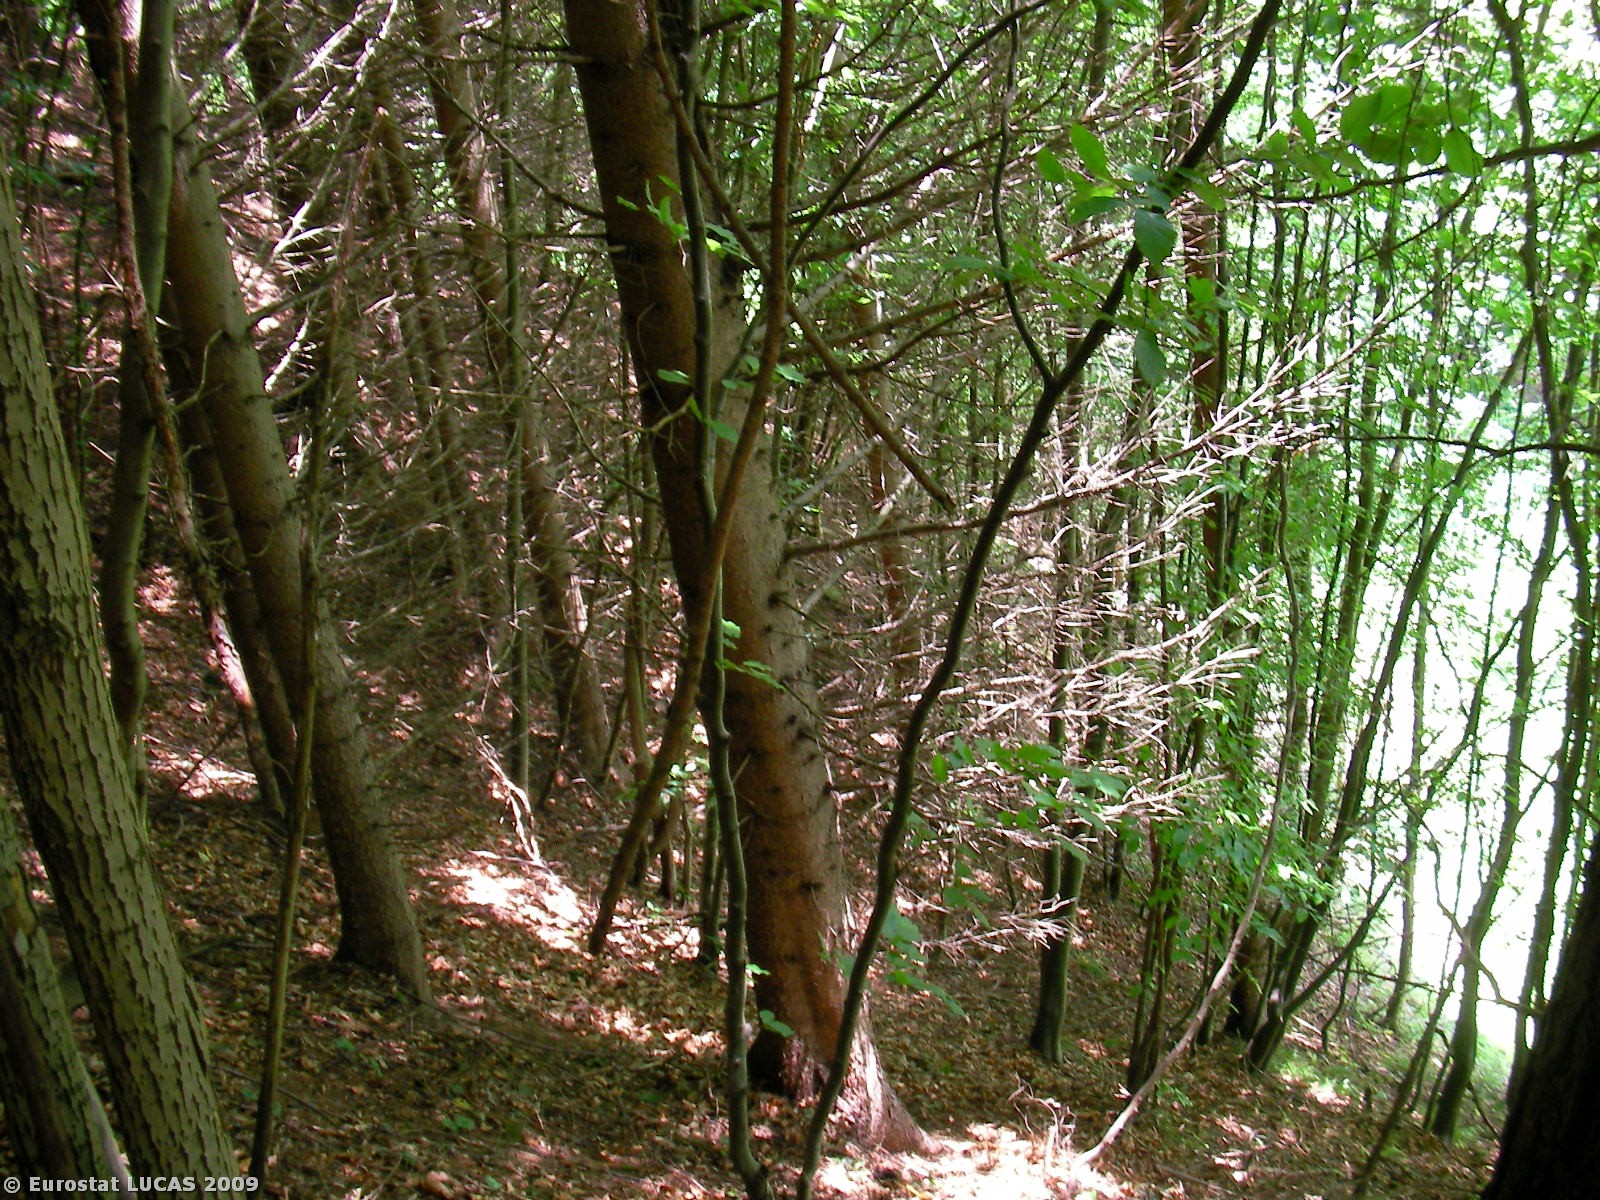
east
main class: Woodland
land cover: Mixed woodland
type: hemiboreal forest and nemoral coniferous forest and mixed broadleaved-coniferous forest
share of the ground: > 75 %
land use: Forestry
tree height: > 5 m
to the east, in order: Mixed woodland; Tracks; Mixed woodland
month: June
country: AT
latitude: 47.3728
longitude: 15.3374
